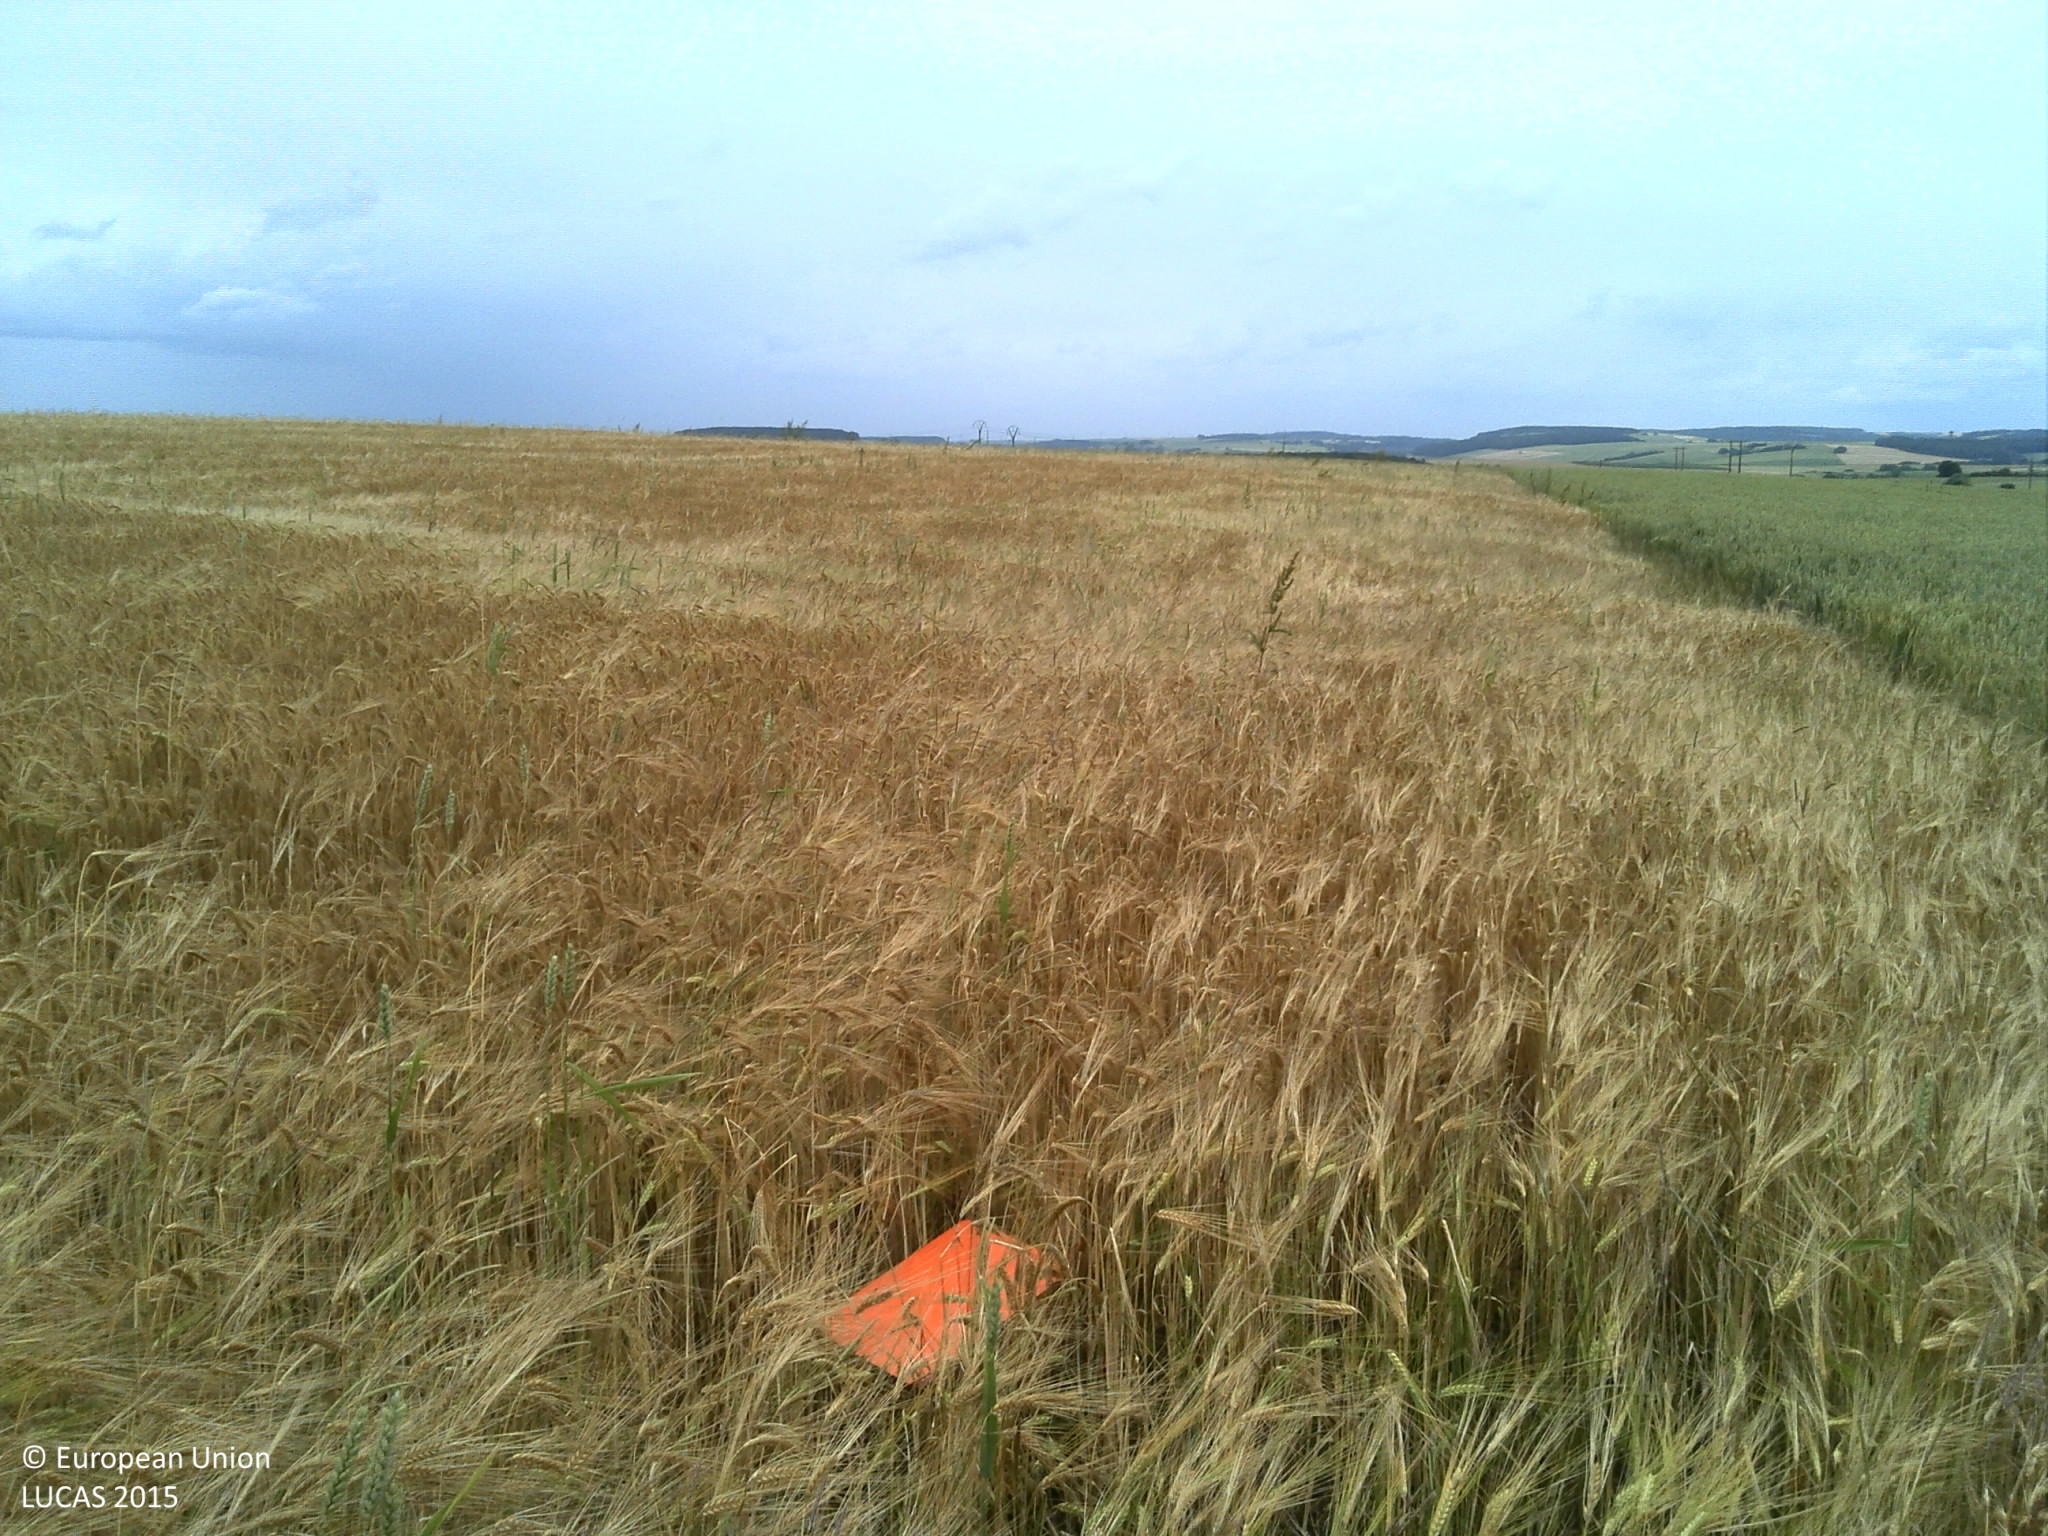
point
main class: Cropland
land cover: Barley
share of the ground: > 75 %
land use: Agriculture (excluding fallow land and kitchen gardens)
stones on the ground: < 10 %
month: June
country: FR
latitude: 49.0670
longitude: 6.4550
